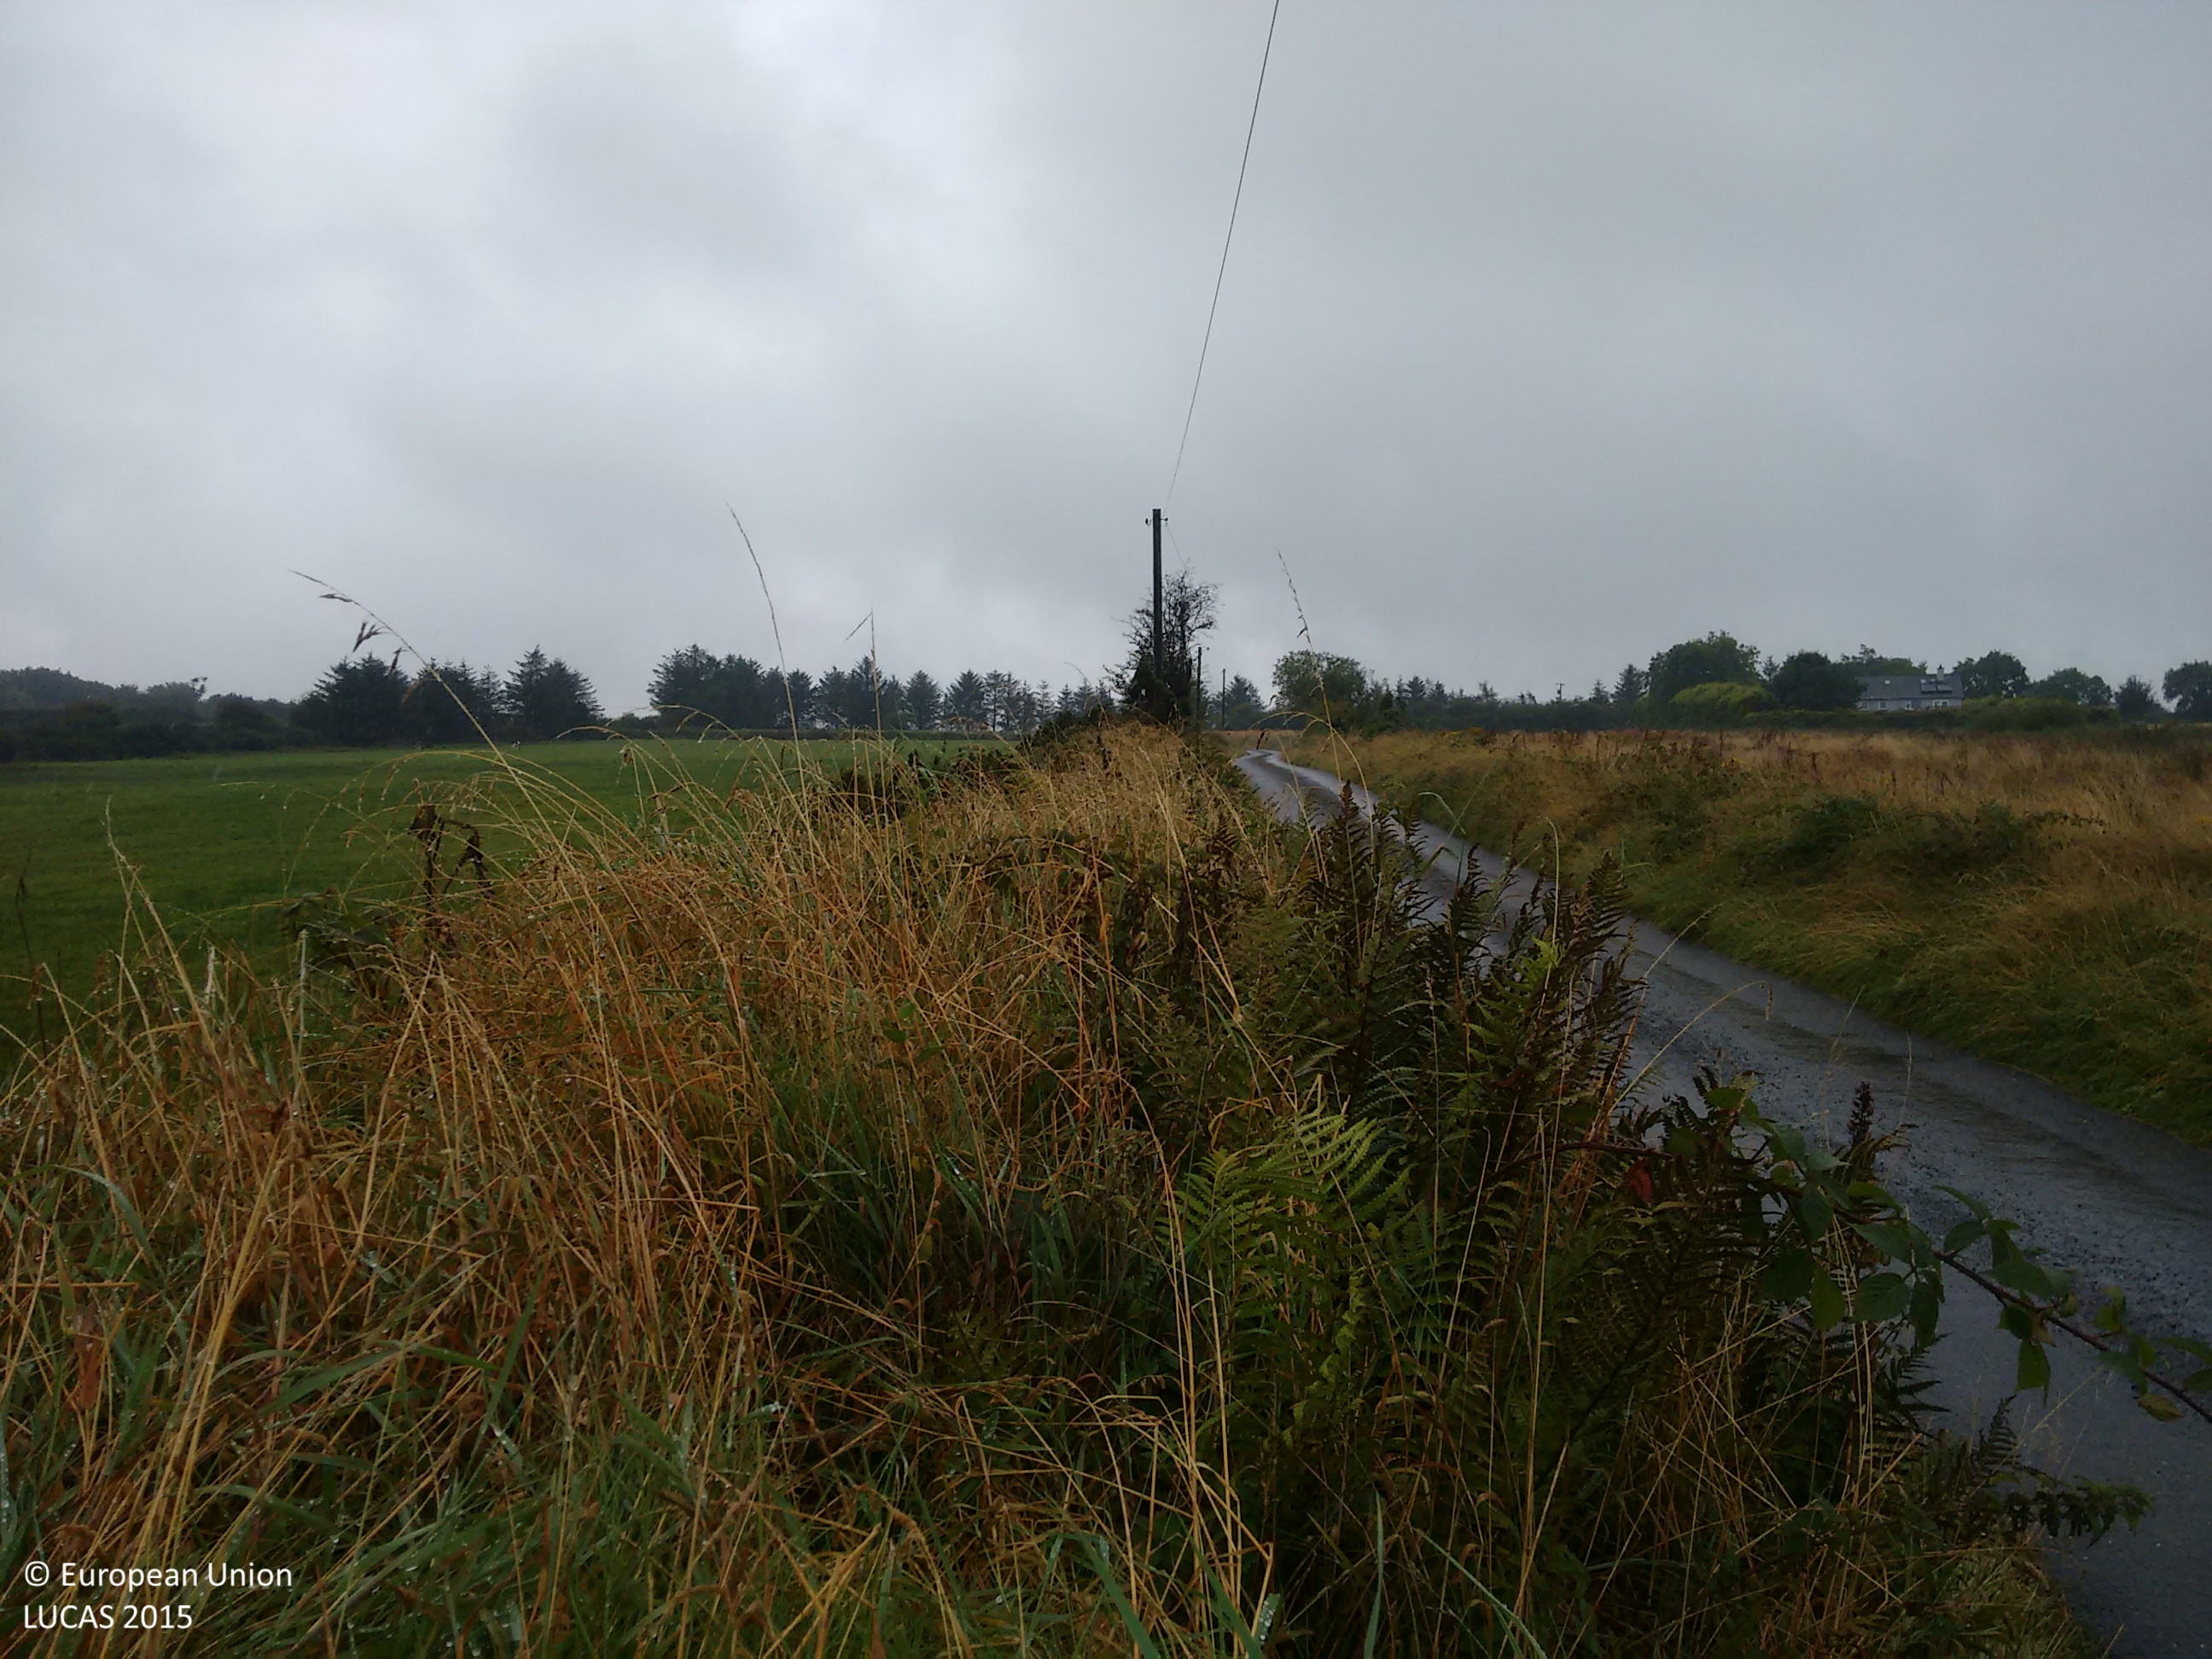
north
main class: Grassland
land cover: Grassland without tree/shrub cover
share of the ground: > 75 %
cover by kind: herbaceous plants 70 %, consolidated bare surface 15 %, shrubs 5 %
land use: Agriculture (excluding fallow land and kitchen gardens)
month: September
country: IE
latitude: 52.2017
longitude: -9.0460
